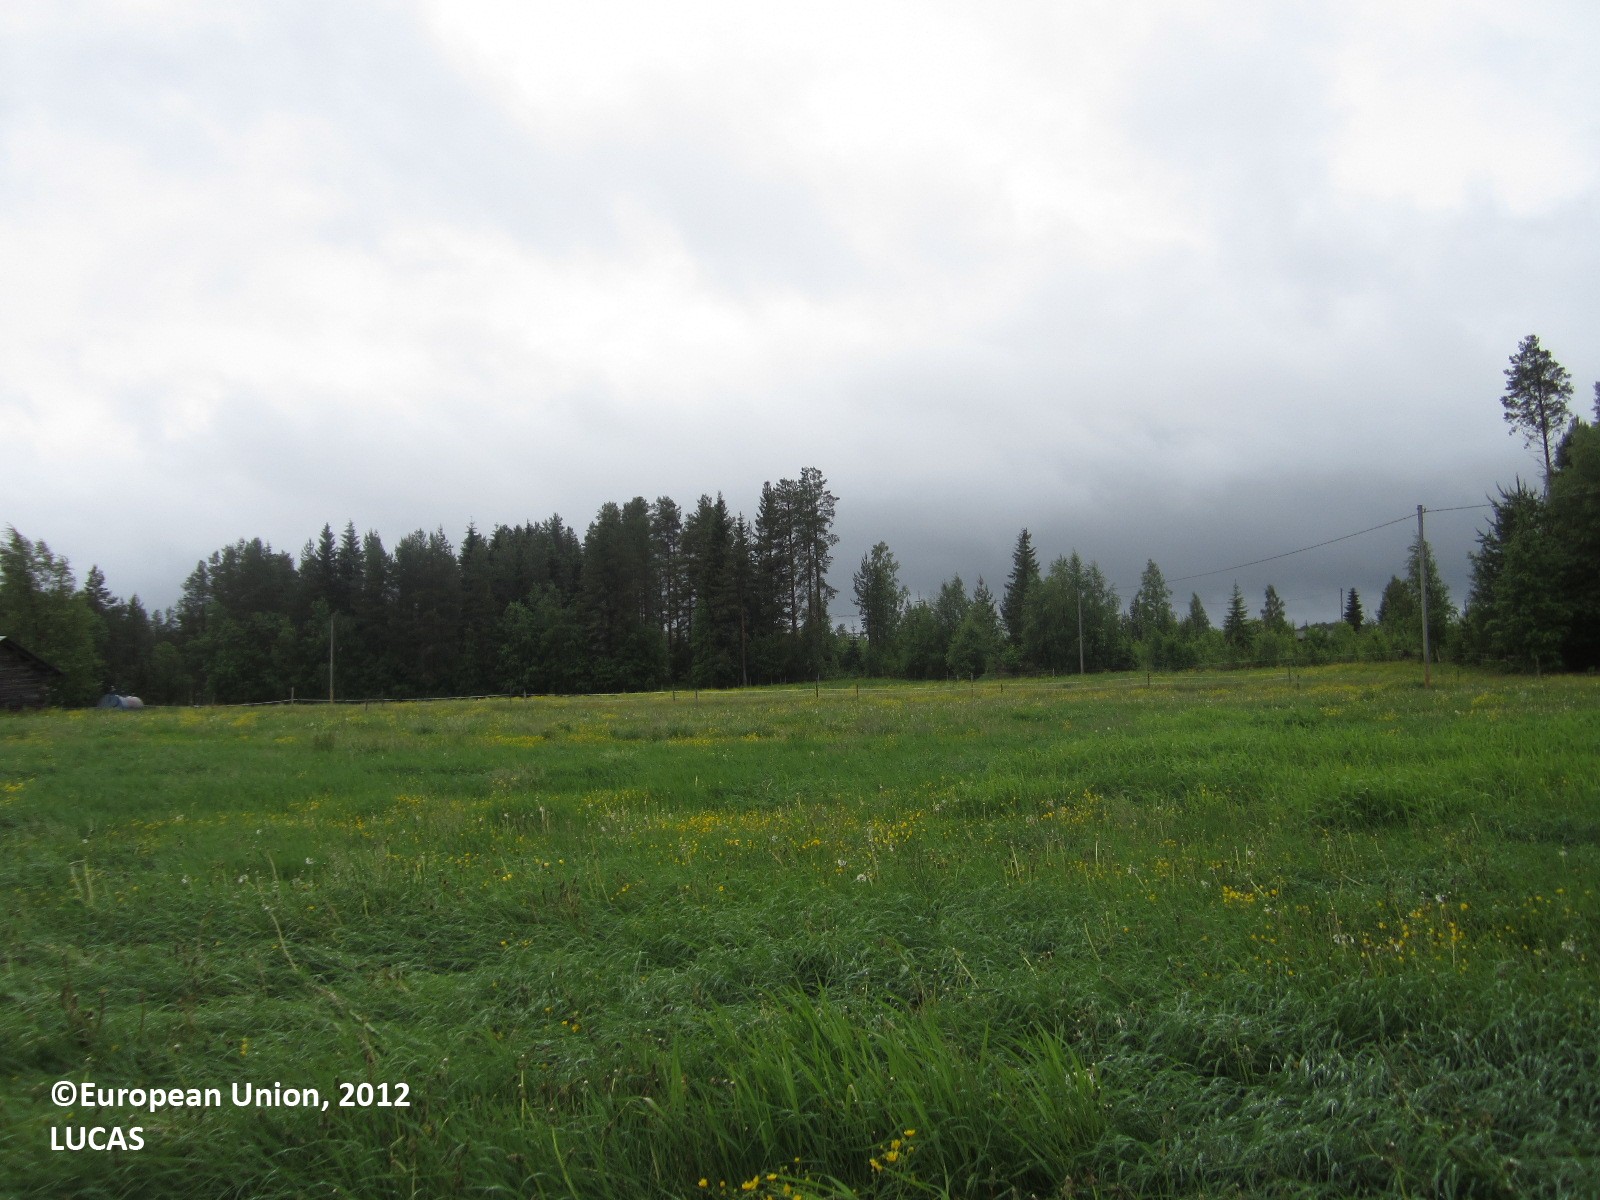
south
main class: Grassland
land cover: Grassland without tree/shrub cover
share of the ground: > 75 %
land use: Agriculture (excluding fallow land and kitchen gardens)
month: June
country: FI
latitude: 64.3054
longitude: 29.5460
